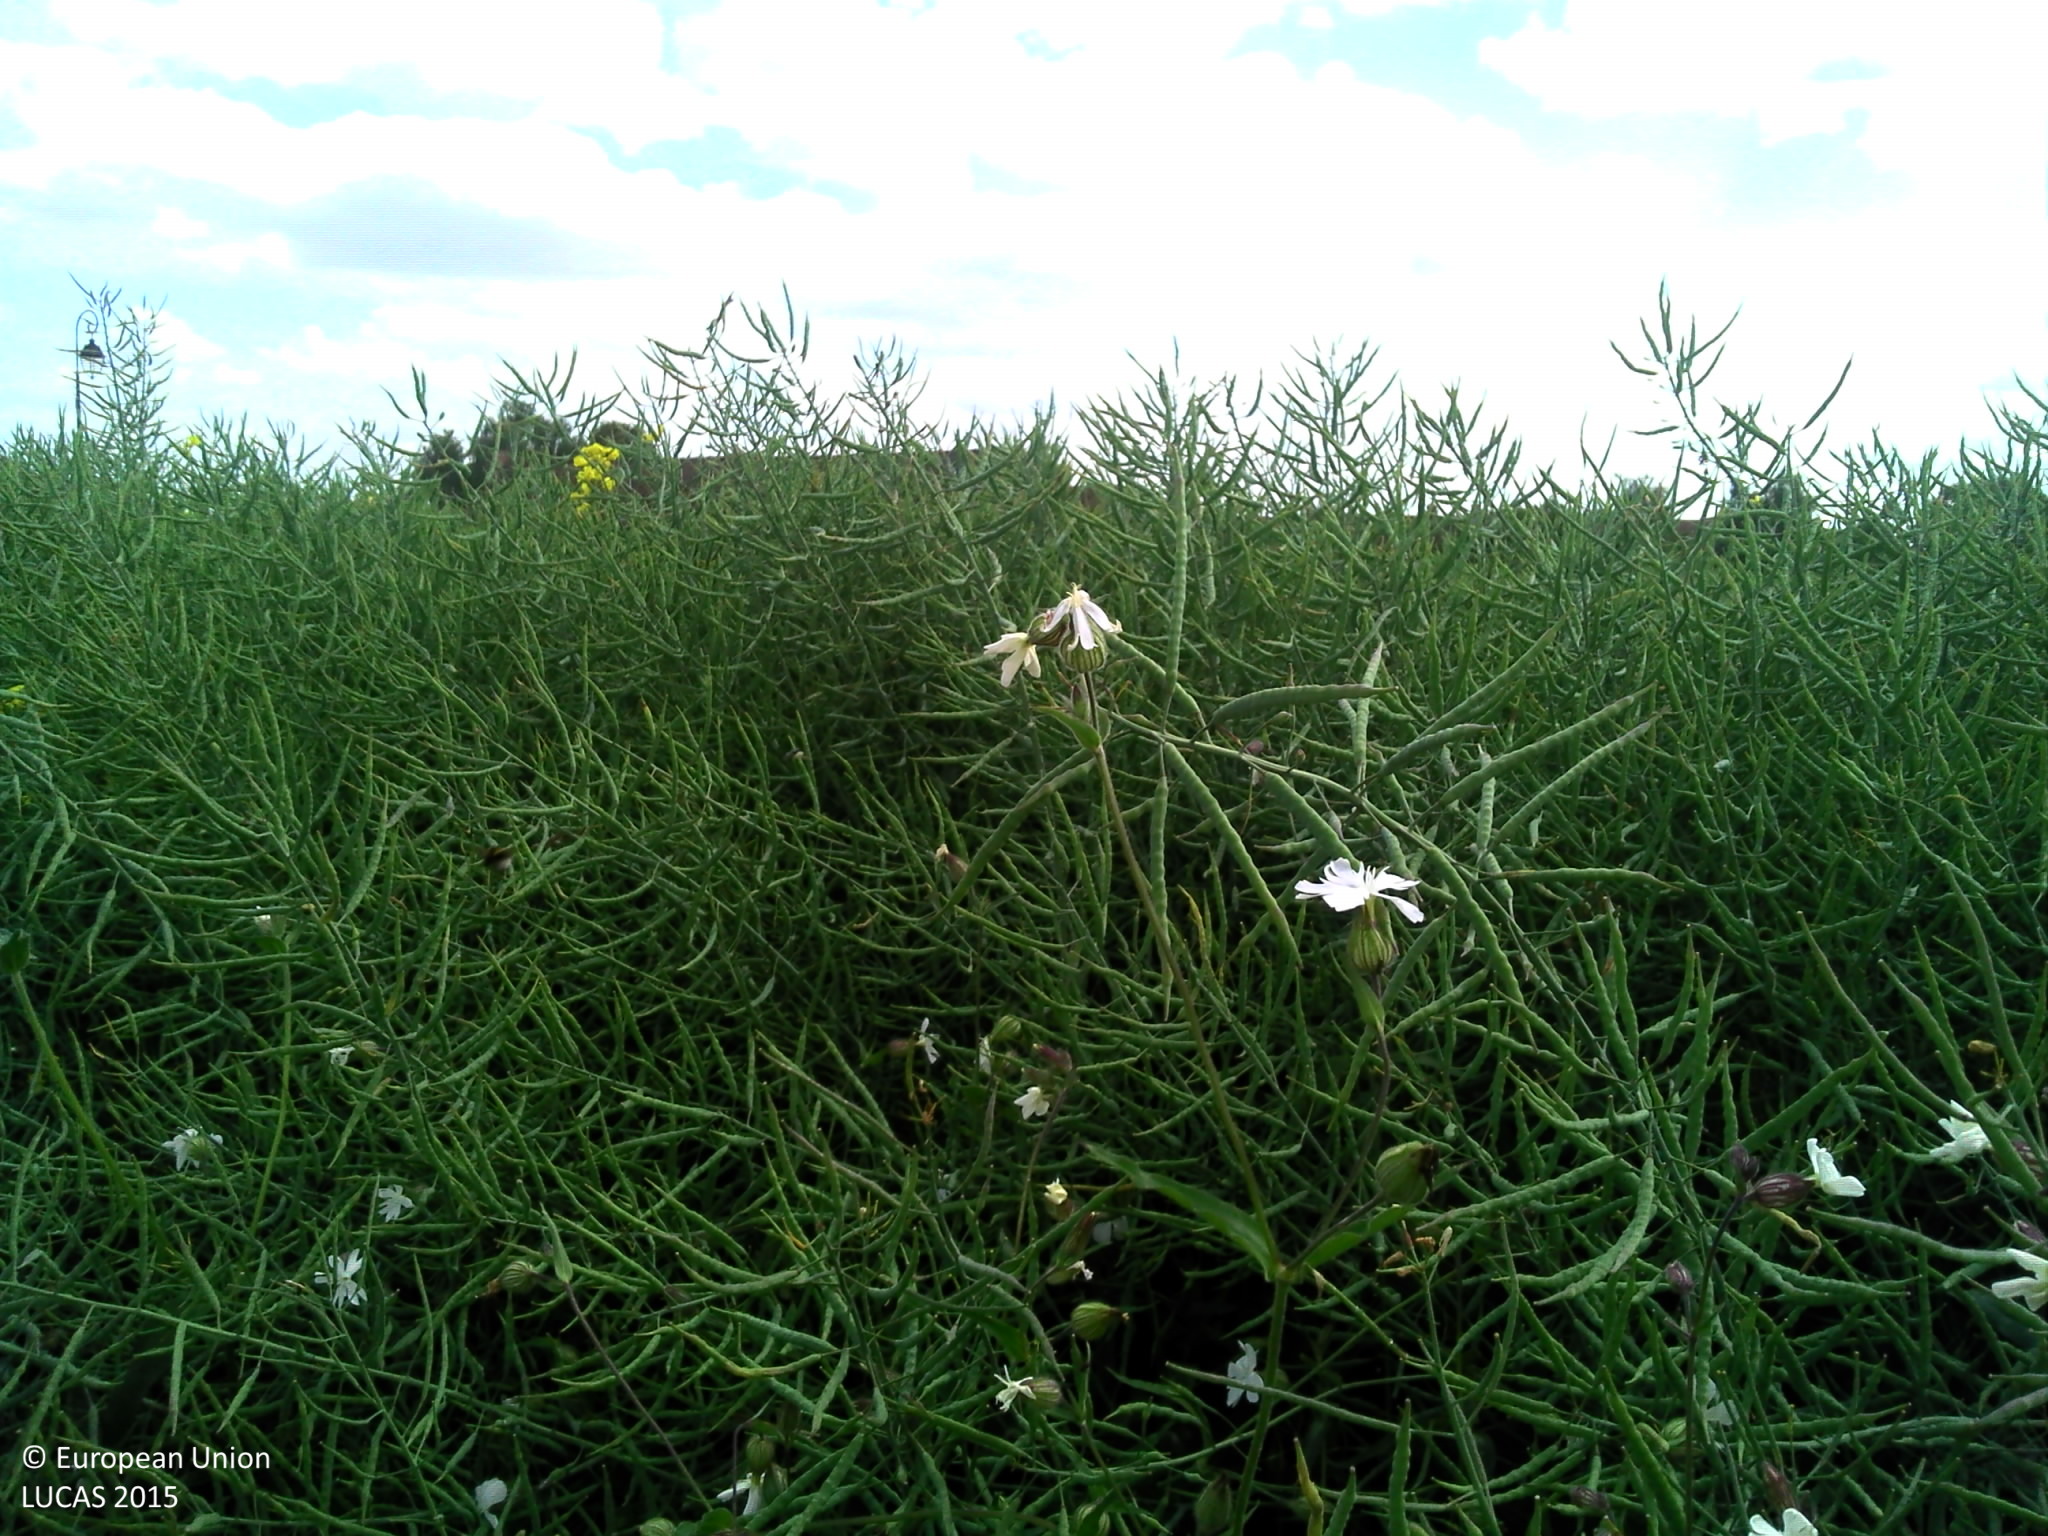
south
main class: Cropland
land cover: Rape and turnip rape
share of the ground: > 75 %
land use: Agriculture (excluding fallow land and kitchen gardens)
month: June
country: FR
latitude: 48.4308
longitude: 1.8903
